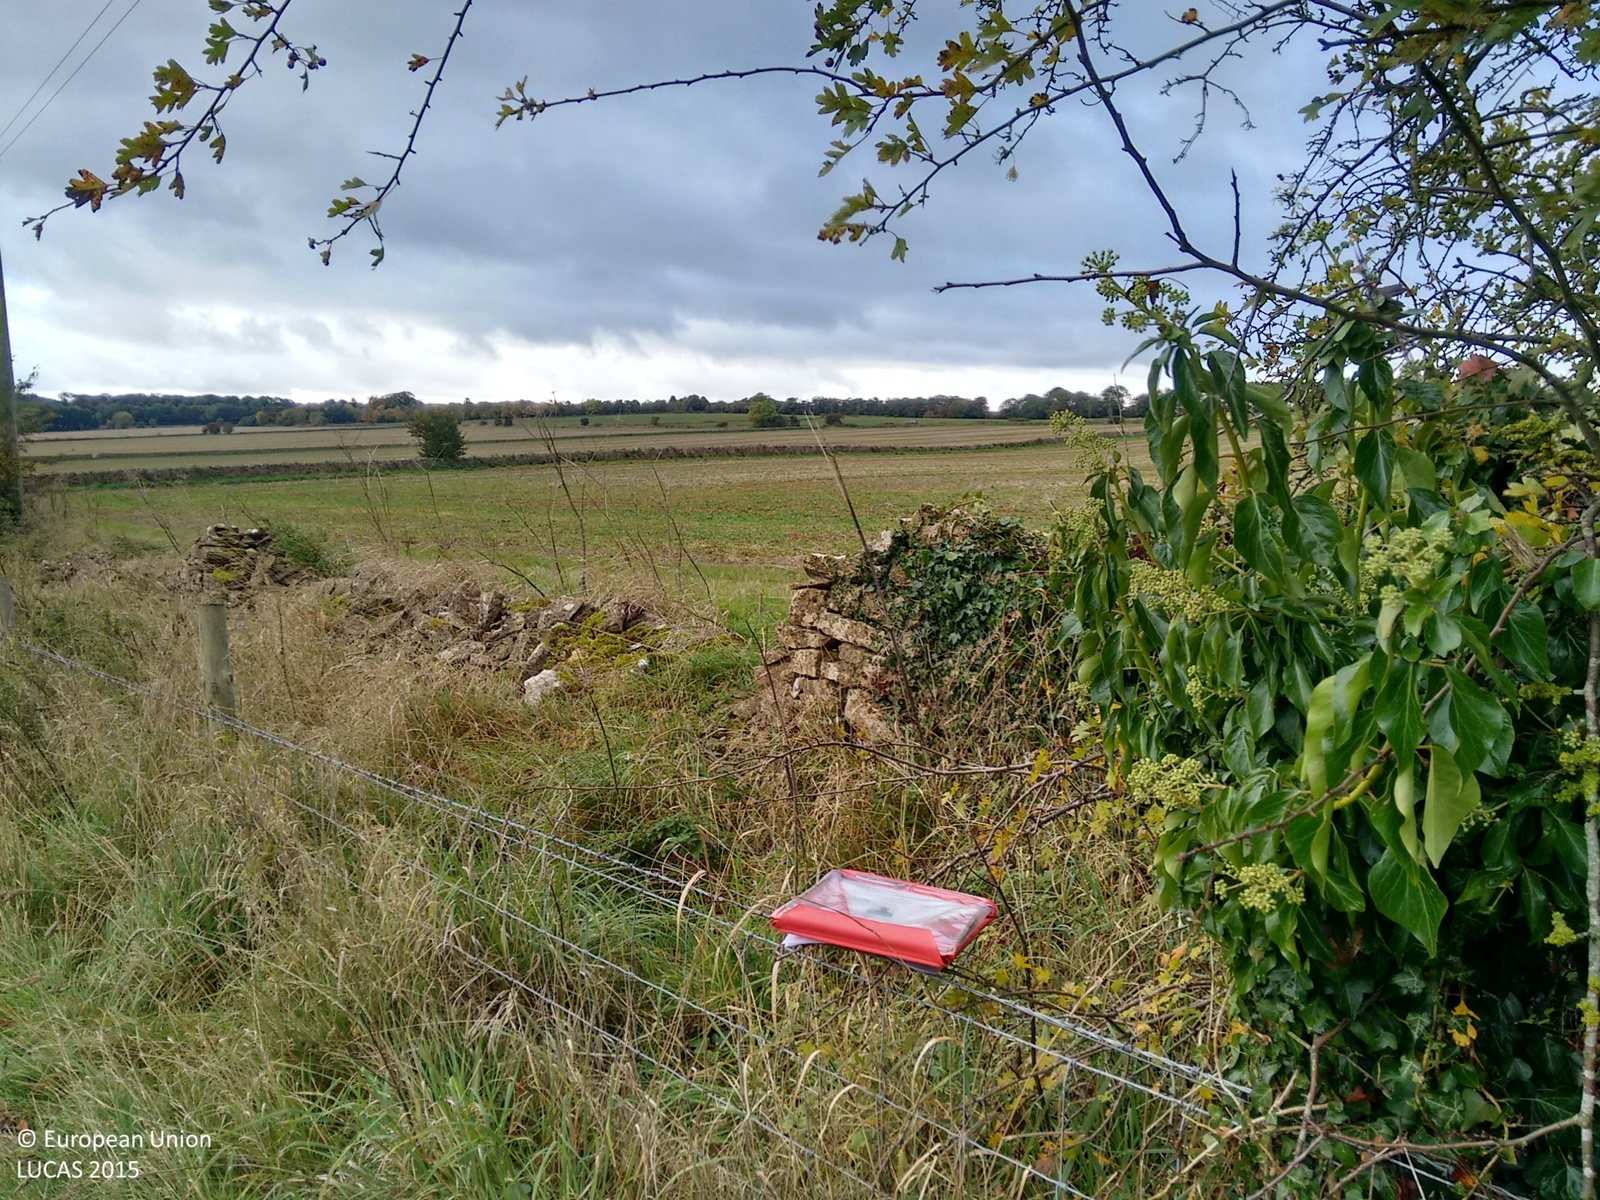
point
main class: Grassland
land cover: Spontaneously vegetated surfaces
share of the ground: > 75 %
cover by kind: herbaceous plants 75 %, unconsolidated bare surface 25 %
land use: Fallow land
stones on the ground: > 50 %
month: October
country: GB
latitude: 52.0389
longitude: -1.8206
